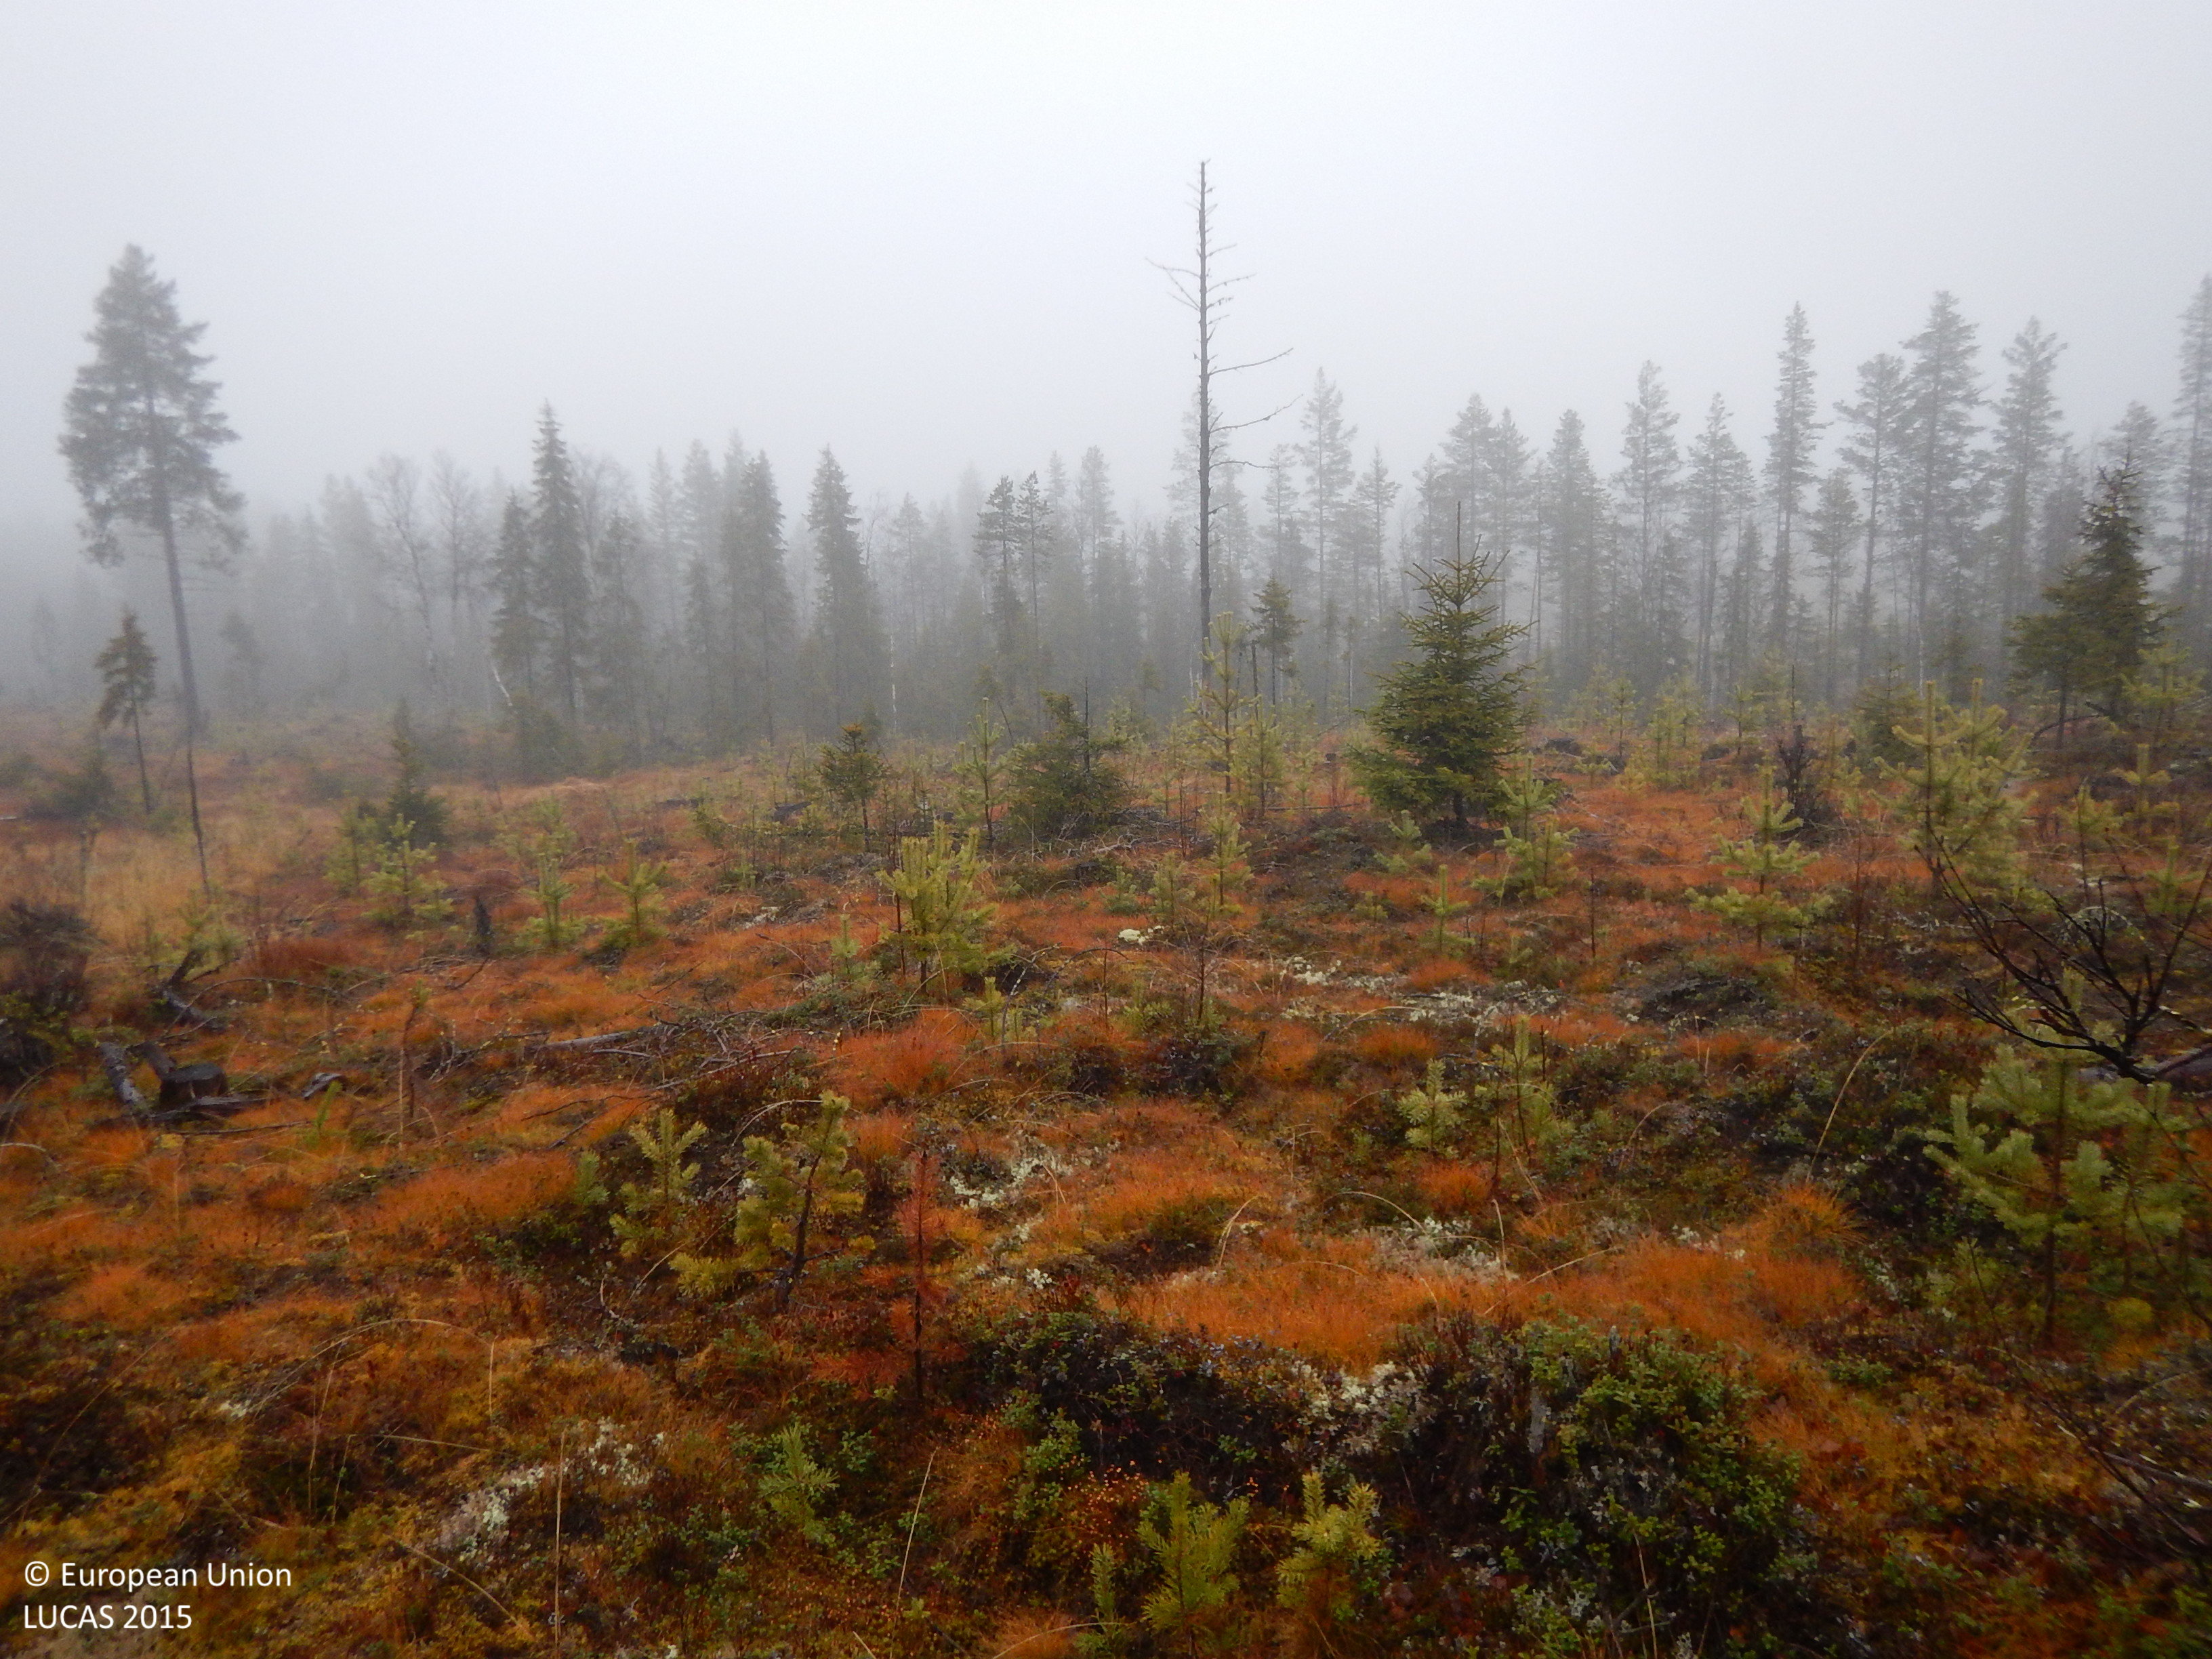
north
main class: Woodland
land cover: Pine dominated coniferous woodland
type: boreal forest
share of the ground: 25 - 50 %
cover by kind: shrubs 35 %, coniferous forest trees 20 %, lichens and mosses 20 %, herbaceous plants 15 %, broadleaved forest trees 5 %, consolidated bare surface 5 %
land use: Forestry
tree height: < 5 m
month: November
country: SE
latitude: 65.0717
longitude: 20.4970
